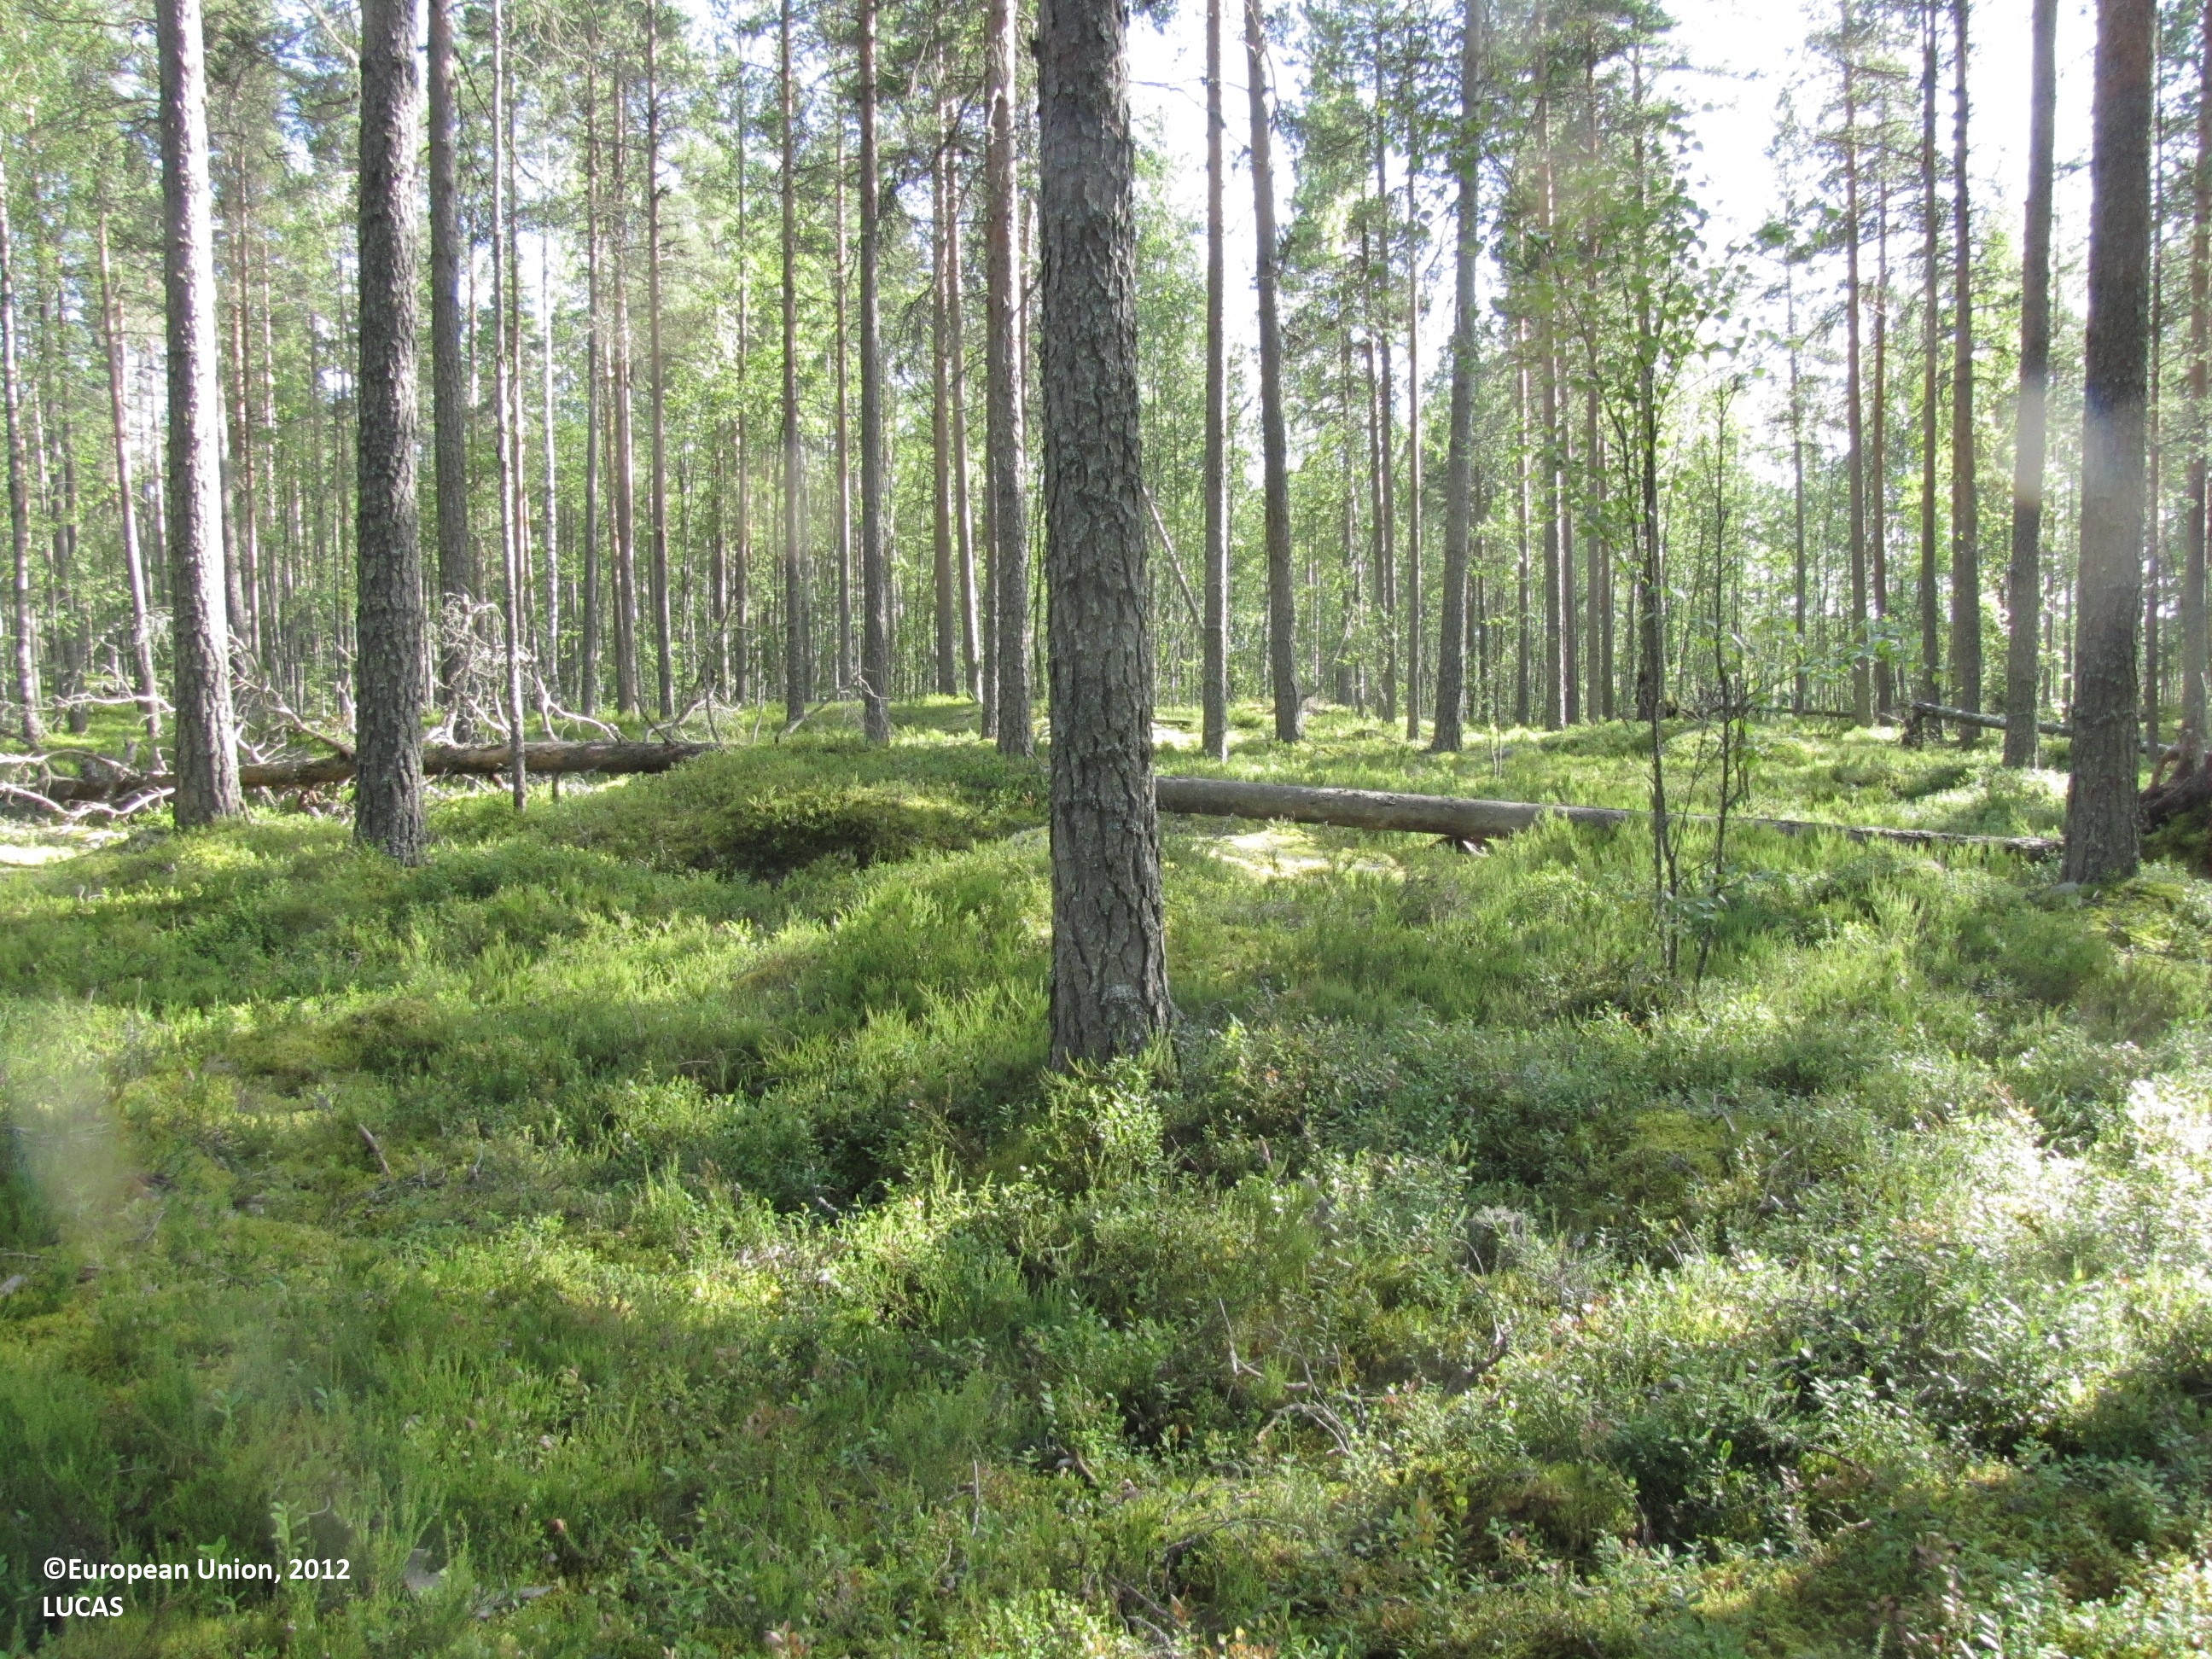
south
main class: Woodland
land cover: Pine dominated coniferous woodland
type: boreal forest
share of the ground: > 75 %
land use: Forestry
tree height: > 5 m
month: July
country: FI
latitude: 62.3625
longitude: 23.1486
